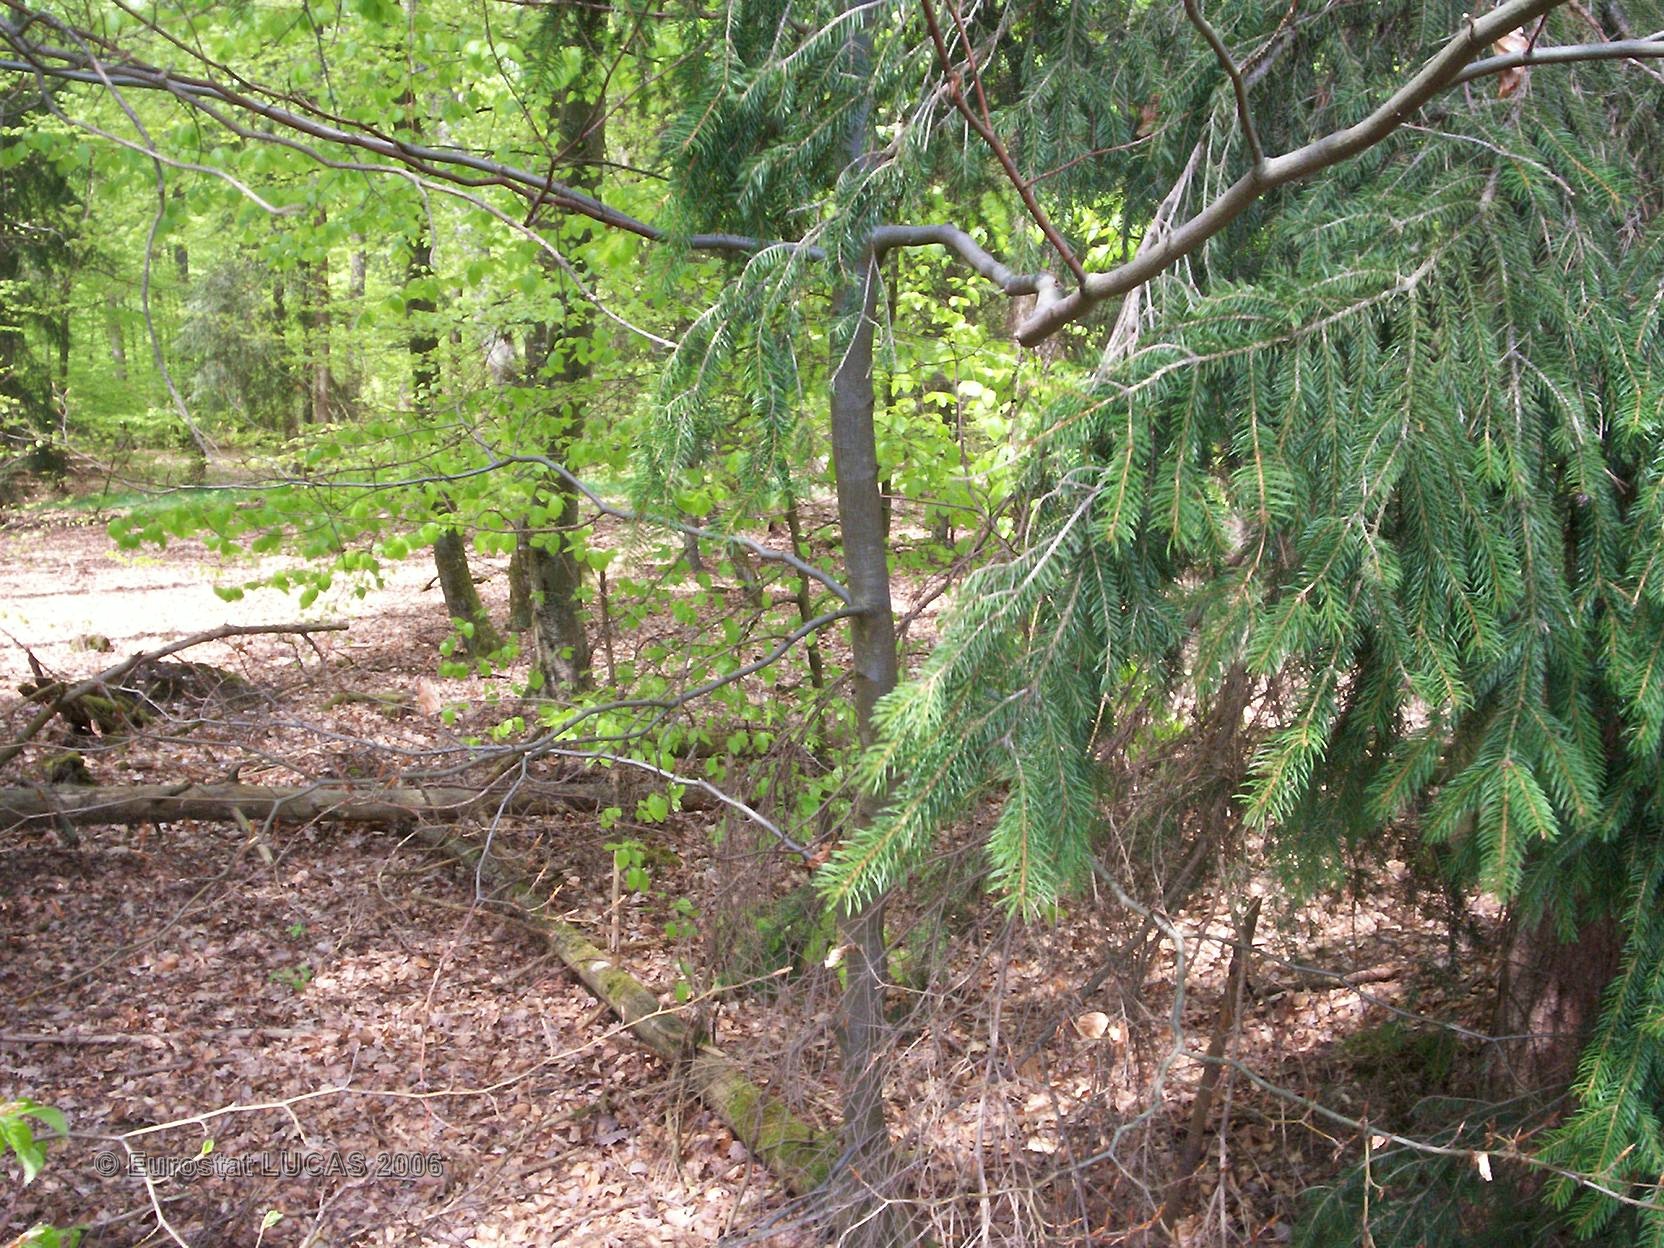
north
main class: Woodland
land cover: Mixed forest
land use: Forestry
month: May
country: FR
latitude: 48.9946
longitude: 7.0620
